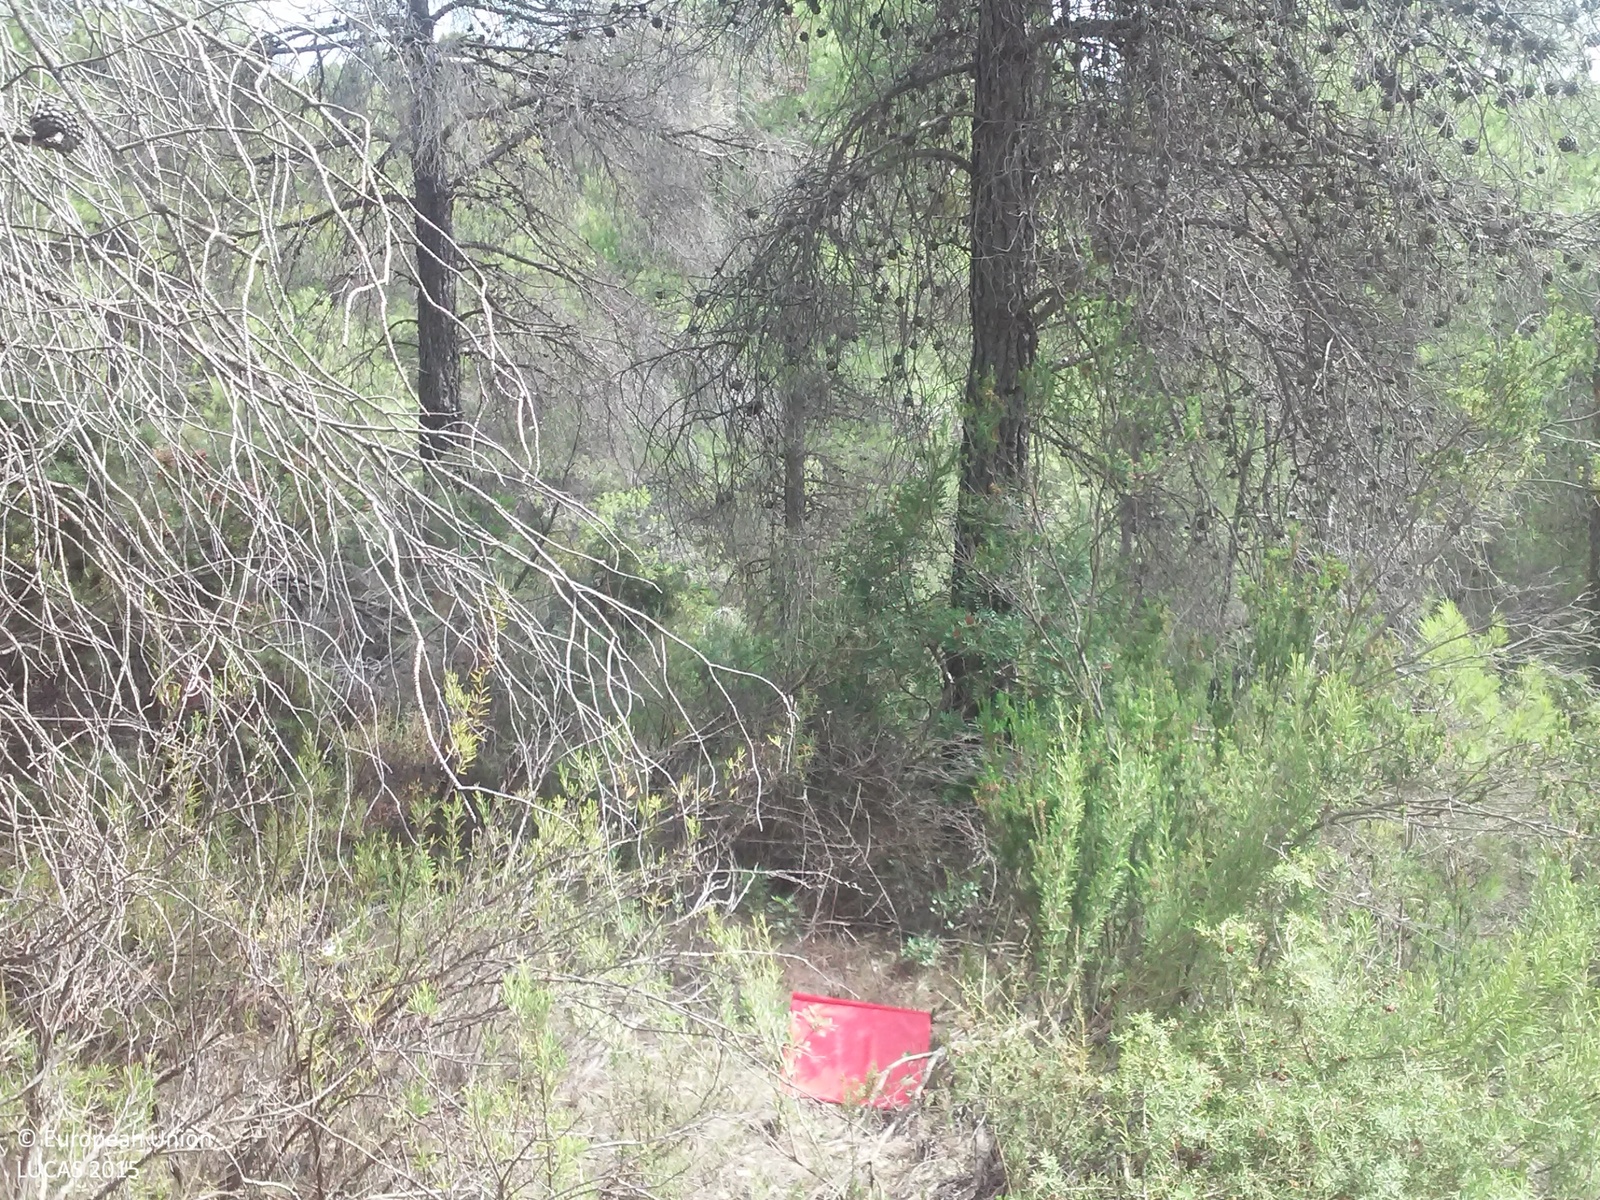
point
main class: Woodland
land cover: Pine dominated coniferous woodland
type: coniferous forest of the mediterranean region
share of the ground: 50 - 75 %
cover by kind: coniferous forest trees 30 %, shrubs 30 %, herbaceous plants 20 %, consolidated bare surface 15 %, broadleaved forest trees 5 %
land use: Semi-natural and natural areas not in use
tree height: > 5 m
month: August
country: ES
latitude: 41.0908
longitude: 0.8140
